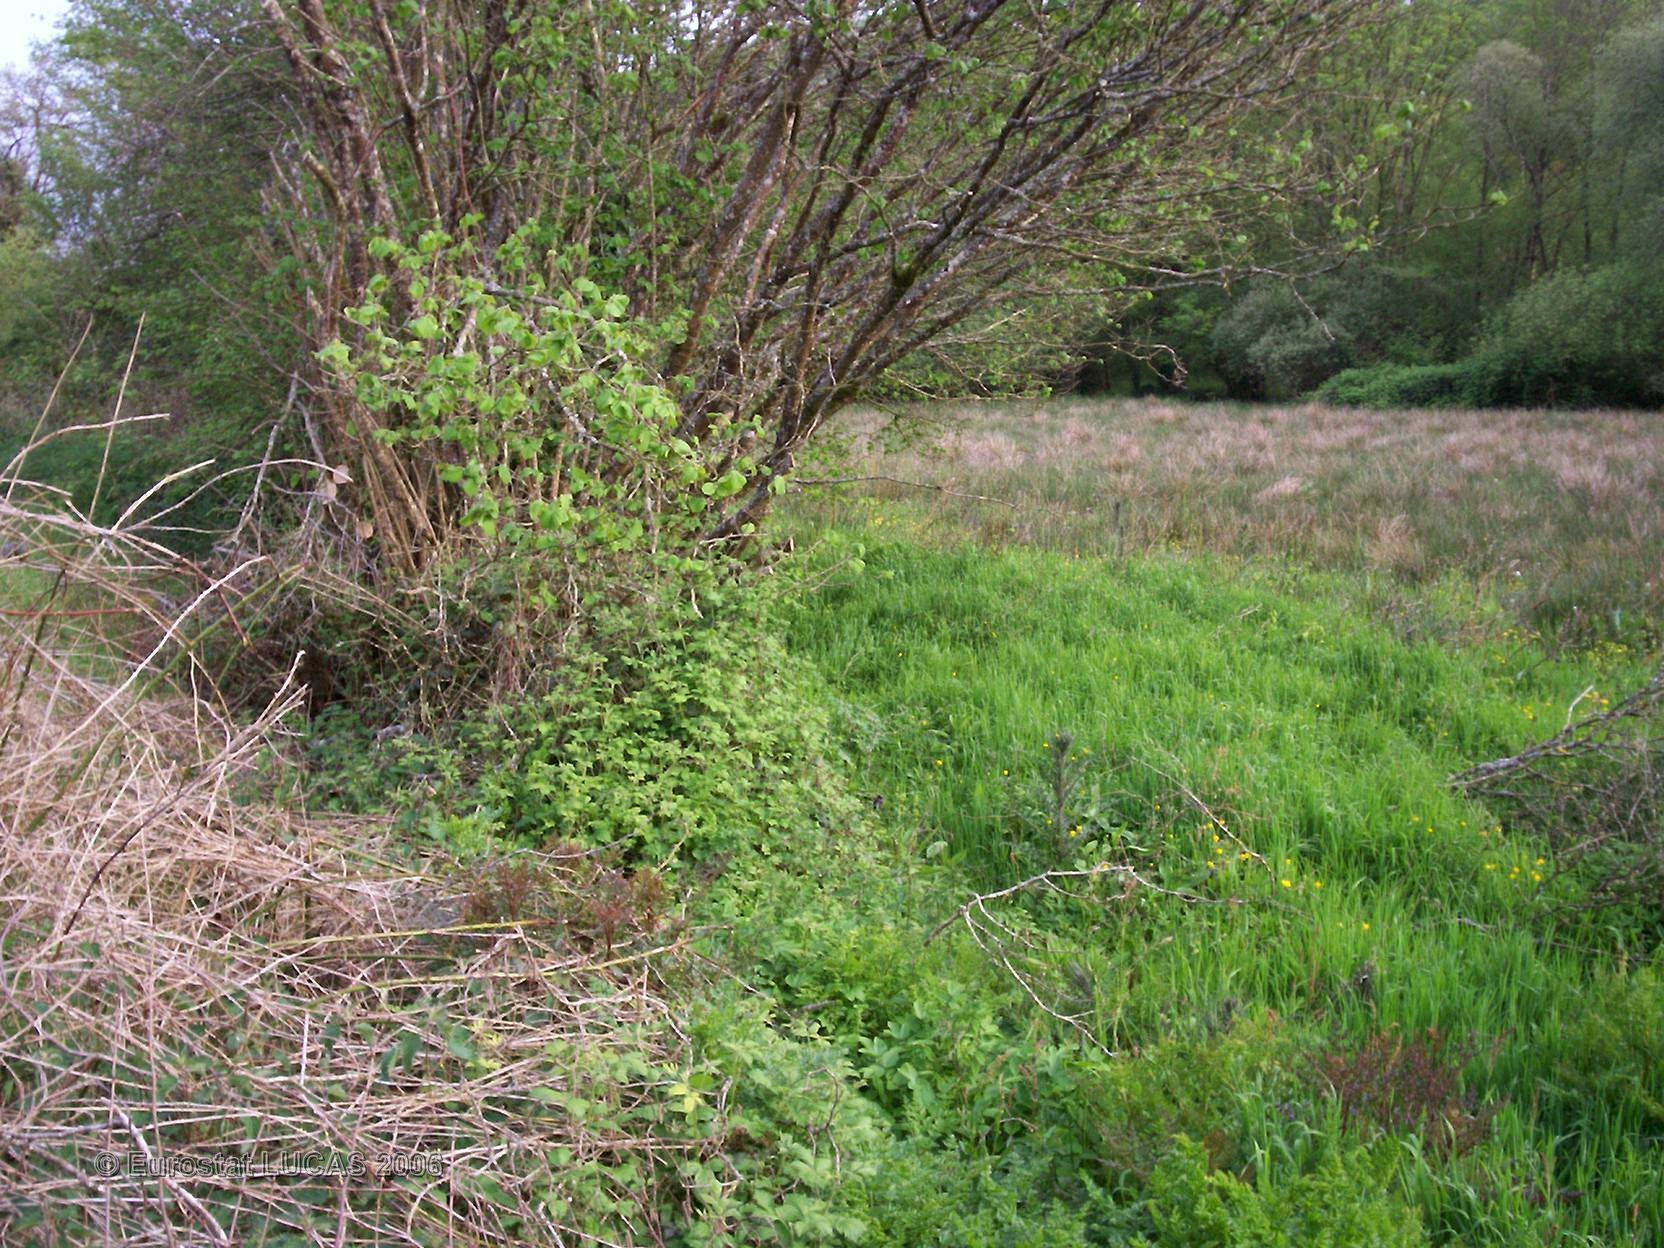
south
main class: Grassland
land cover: Grassland without tree/shrub cover
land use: Agriculture (excluding fallow land and kitchen gardens)
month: May
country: FR
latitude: 48.1568
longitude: -3.9185
